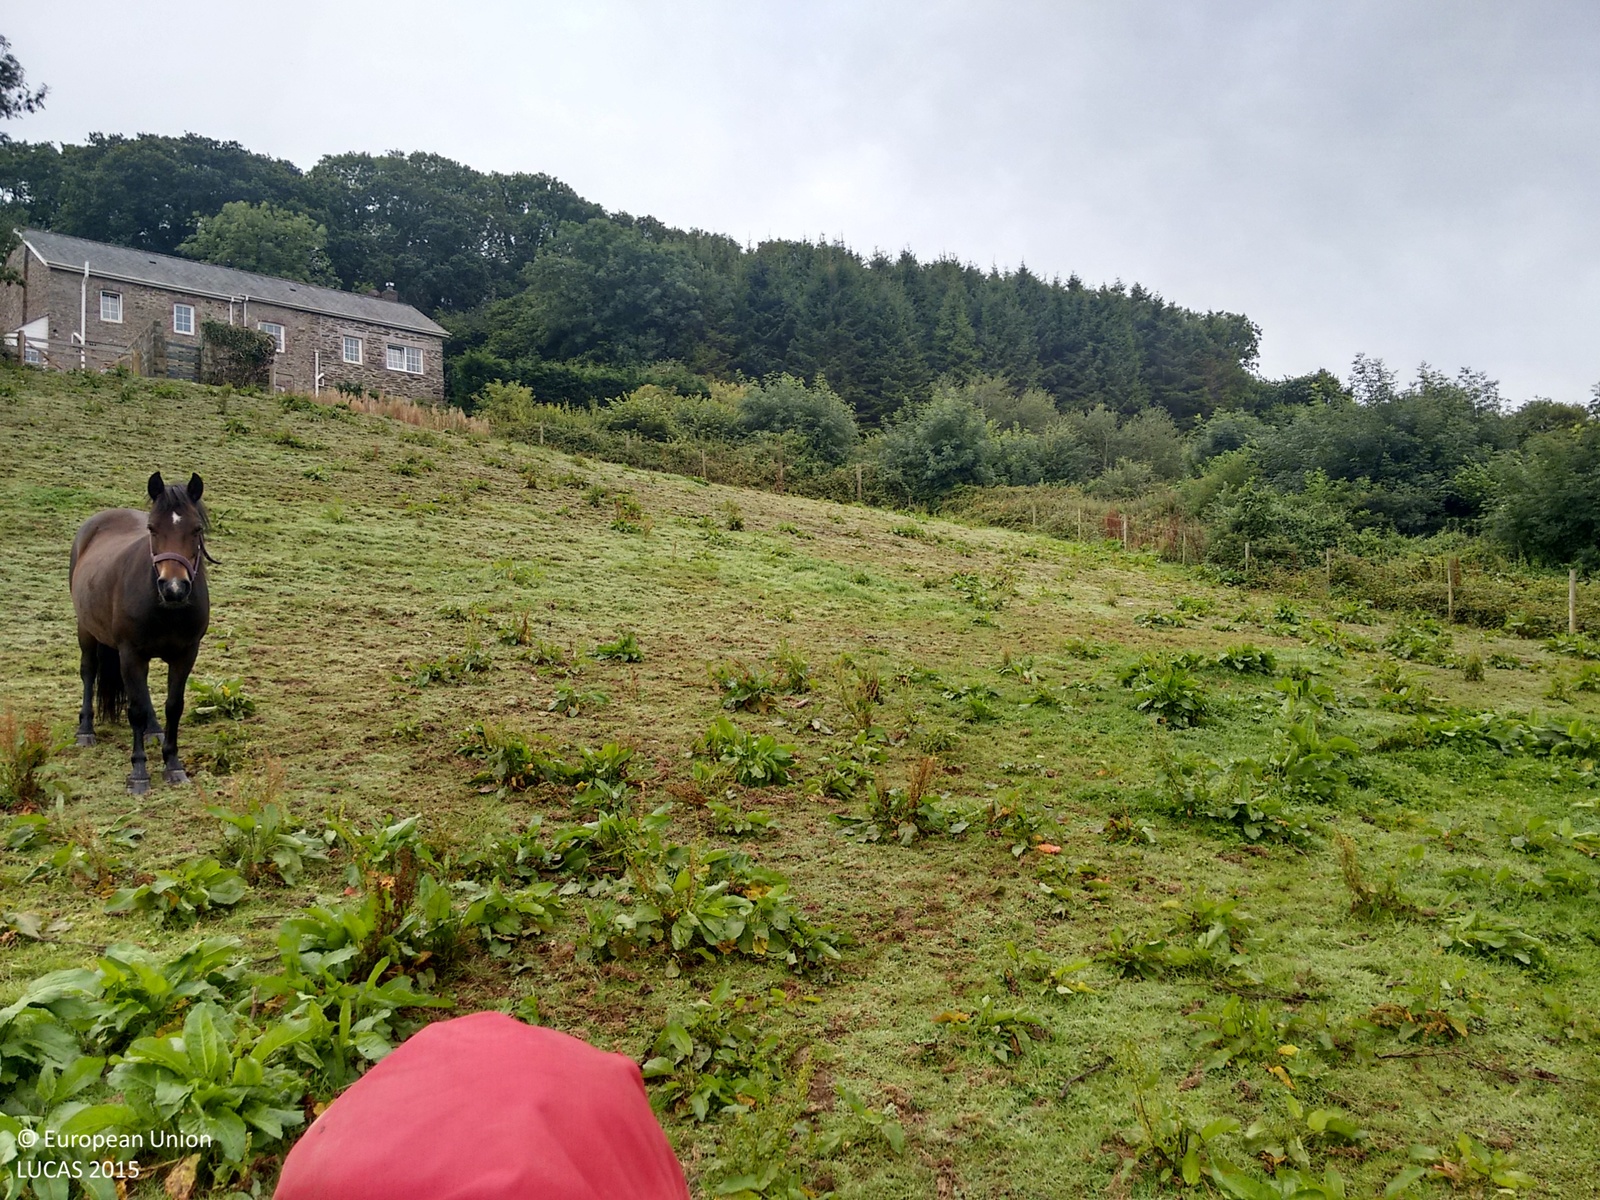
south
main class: Shrubland
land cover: Shrubland without tree cover
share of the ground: > 75 %
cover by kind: shrubs 100 %
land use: Semi-natural and natural areas not in use
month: August
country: GB
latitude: 50.3604
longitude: -4.2540
